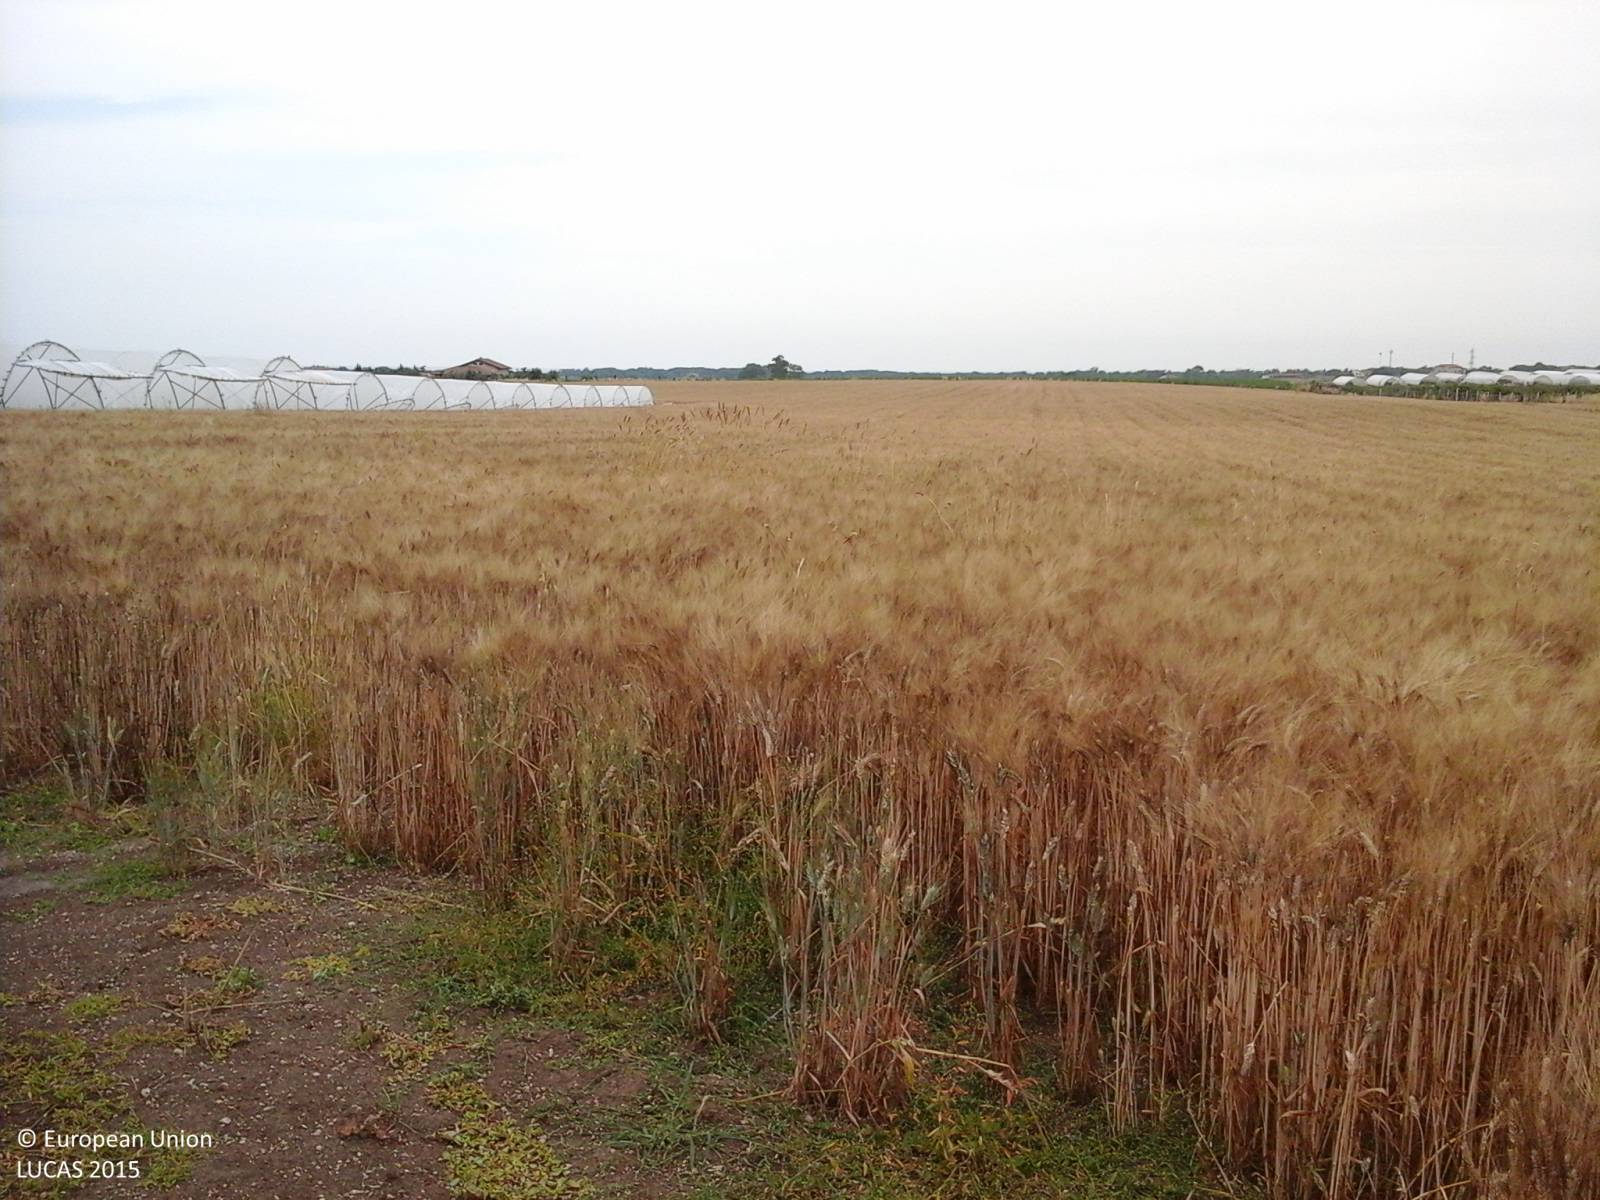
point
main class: Cropland
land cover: Durum wheat
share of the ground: > 75 %
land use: Agriculture (excluding fallow land and kitchen gardens)
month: June
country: IT
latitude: 42.3905
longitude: 11.4647
